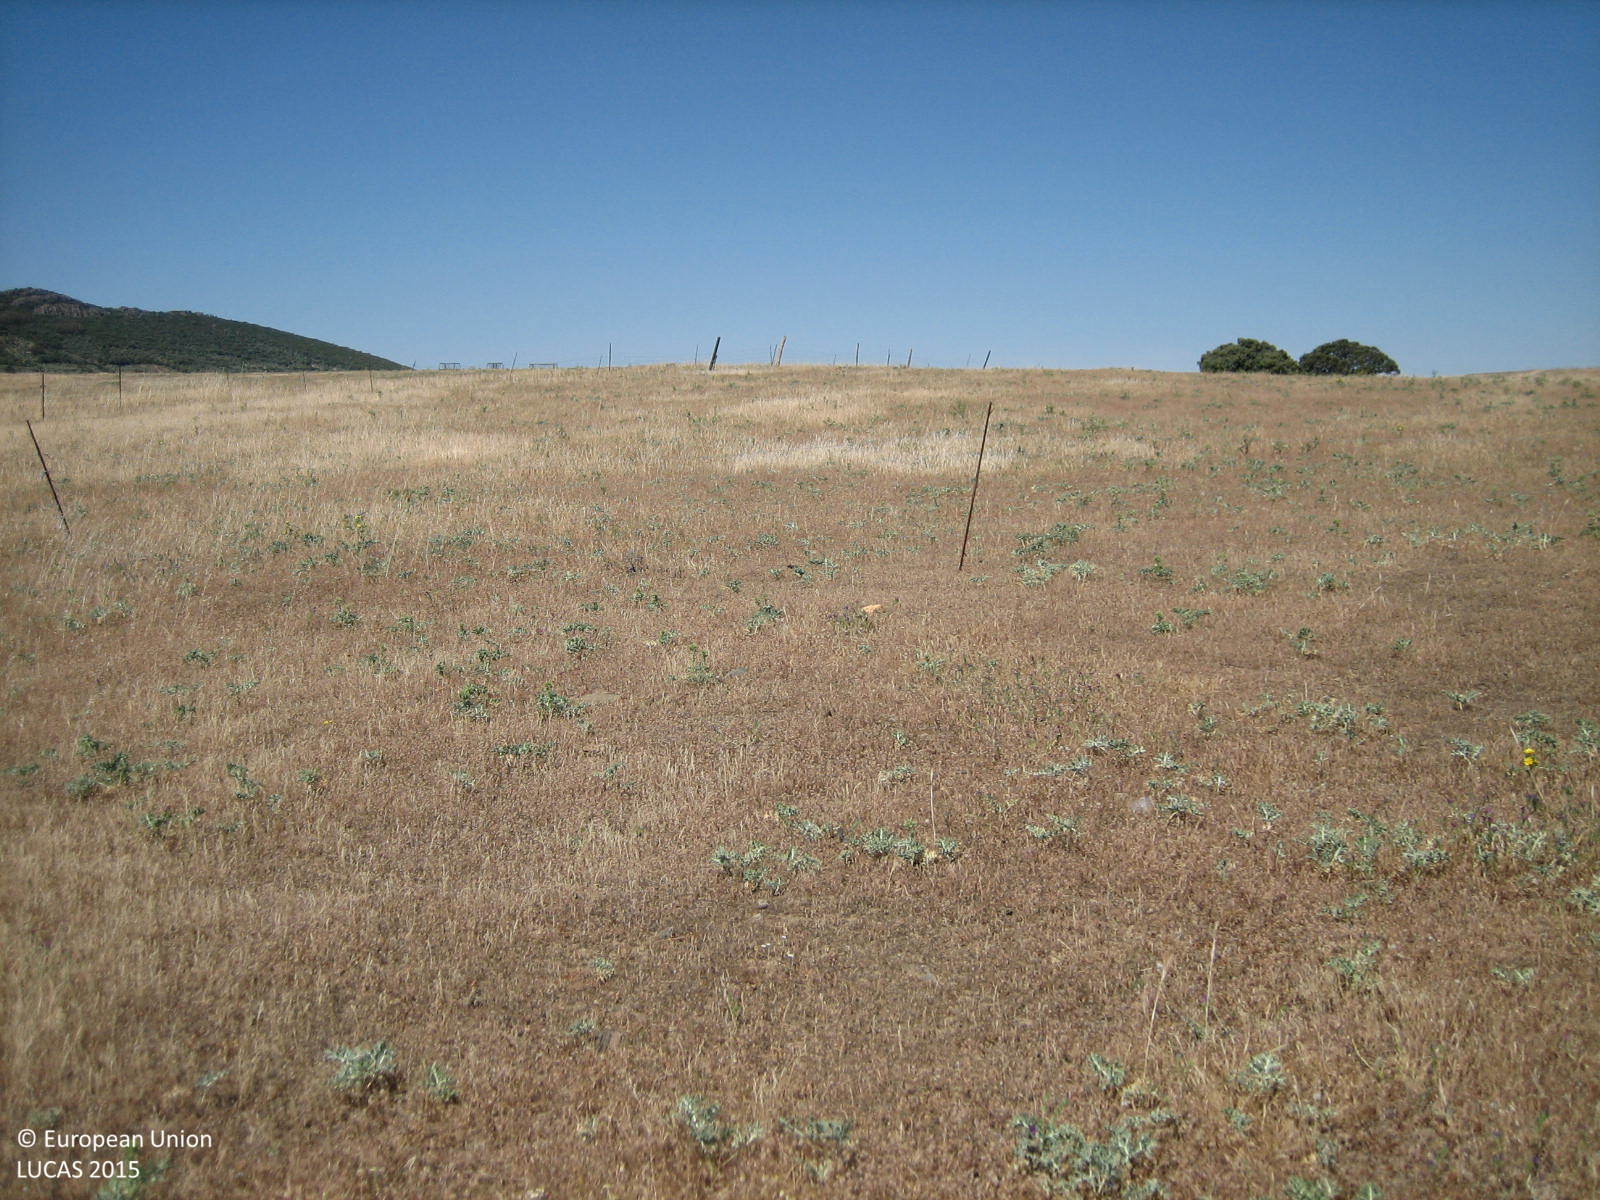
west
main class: Grassland
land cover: Spontaneously vegetated surfaces
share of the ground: > 75 %
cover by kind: herbaceous plants 100 %
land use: Agriculture (excluding fallow land and kitchen gardens)
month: May
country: ES
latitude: 38.9948
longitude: -4.8935
